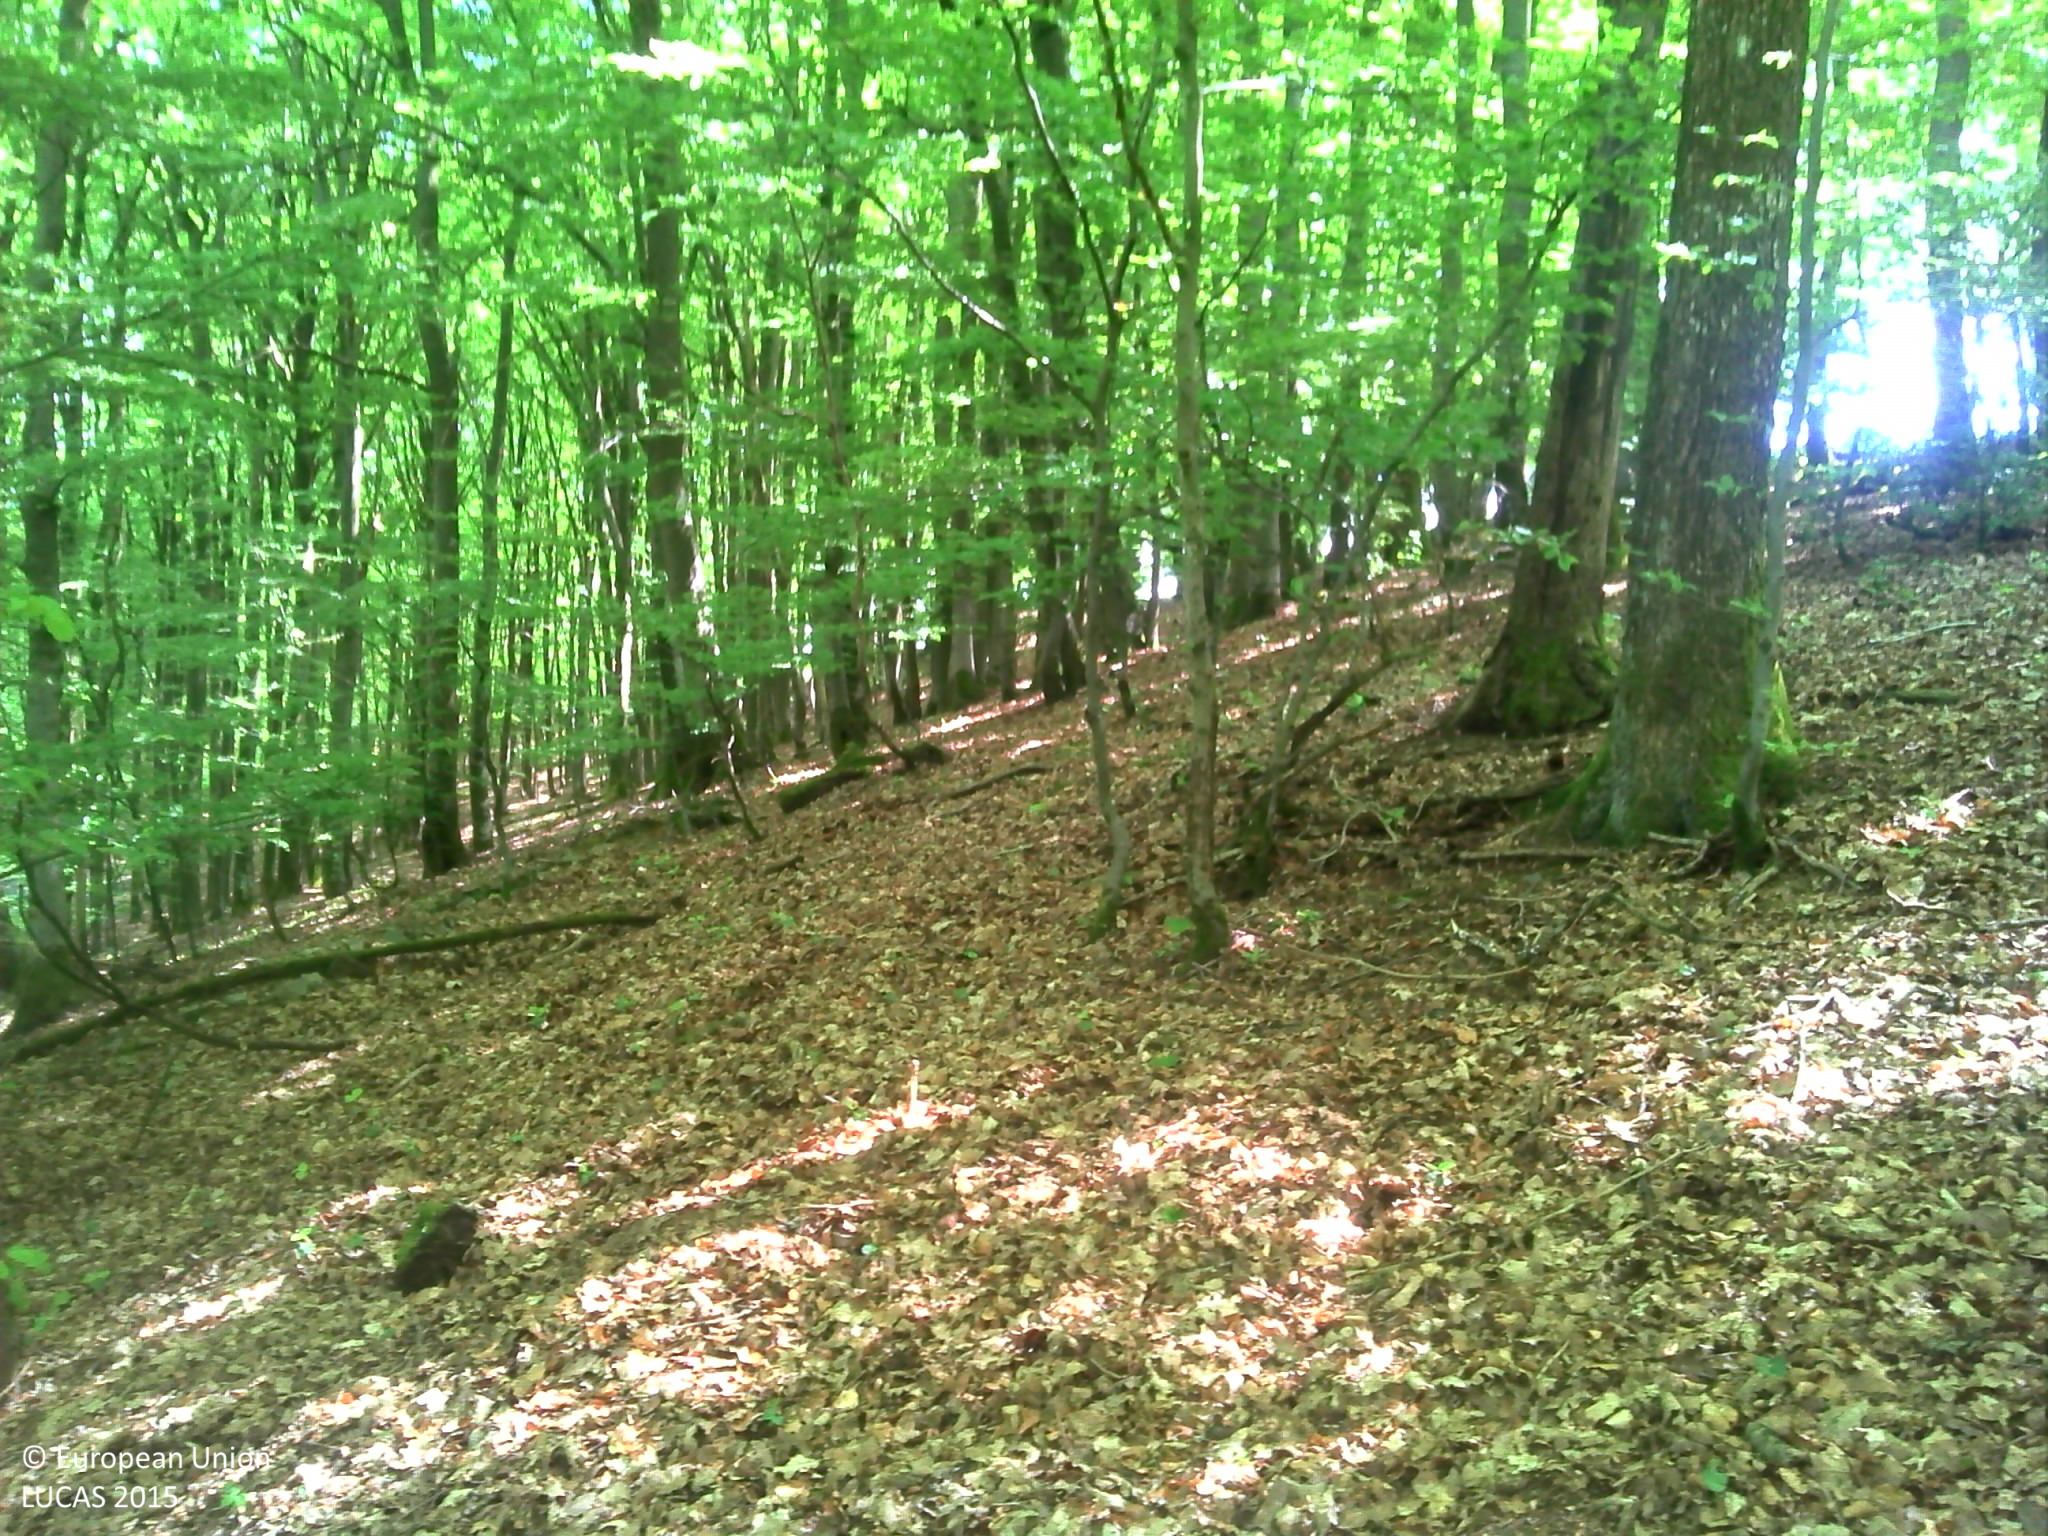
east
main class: Woodland
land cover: Broadleaved woodland
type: acidophilous oak and oak-birch forest
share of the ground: > 75 %
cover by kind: broadleaved forest trees 100 %
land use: Forestry
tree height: > 5 m
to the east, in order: Broadleaved woodland; Maize
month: May
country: LU
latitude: 49.8583
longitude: 5.8955
